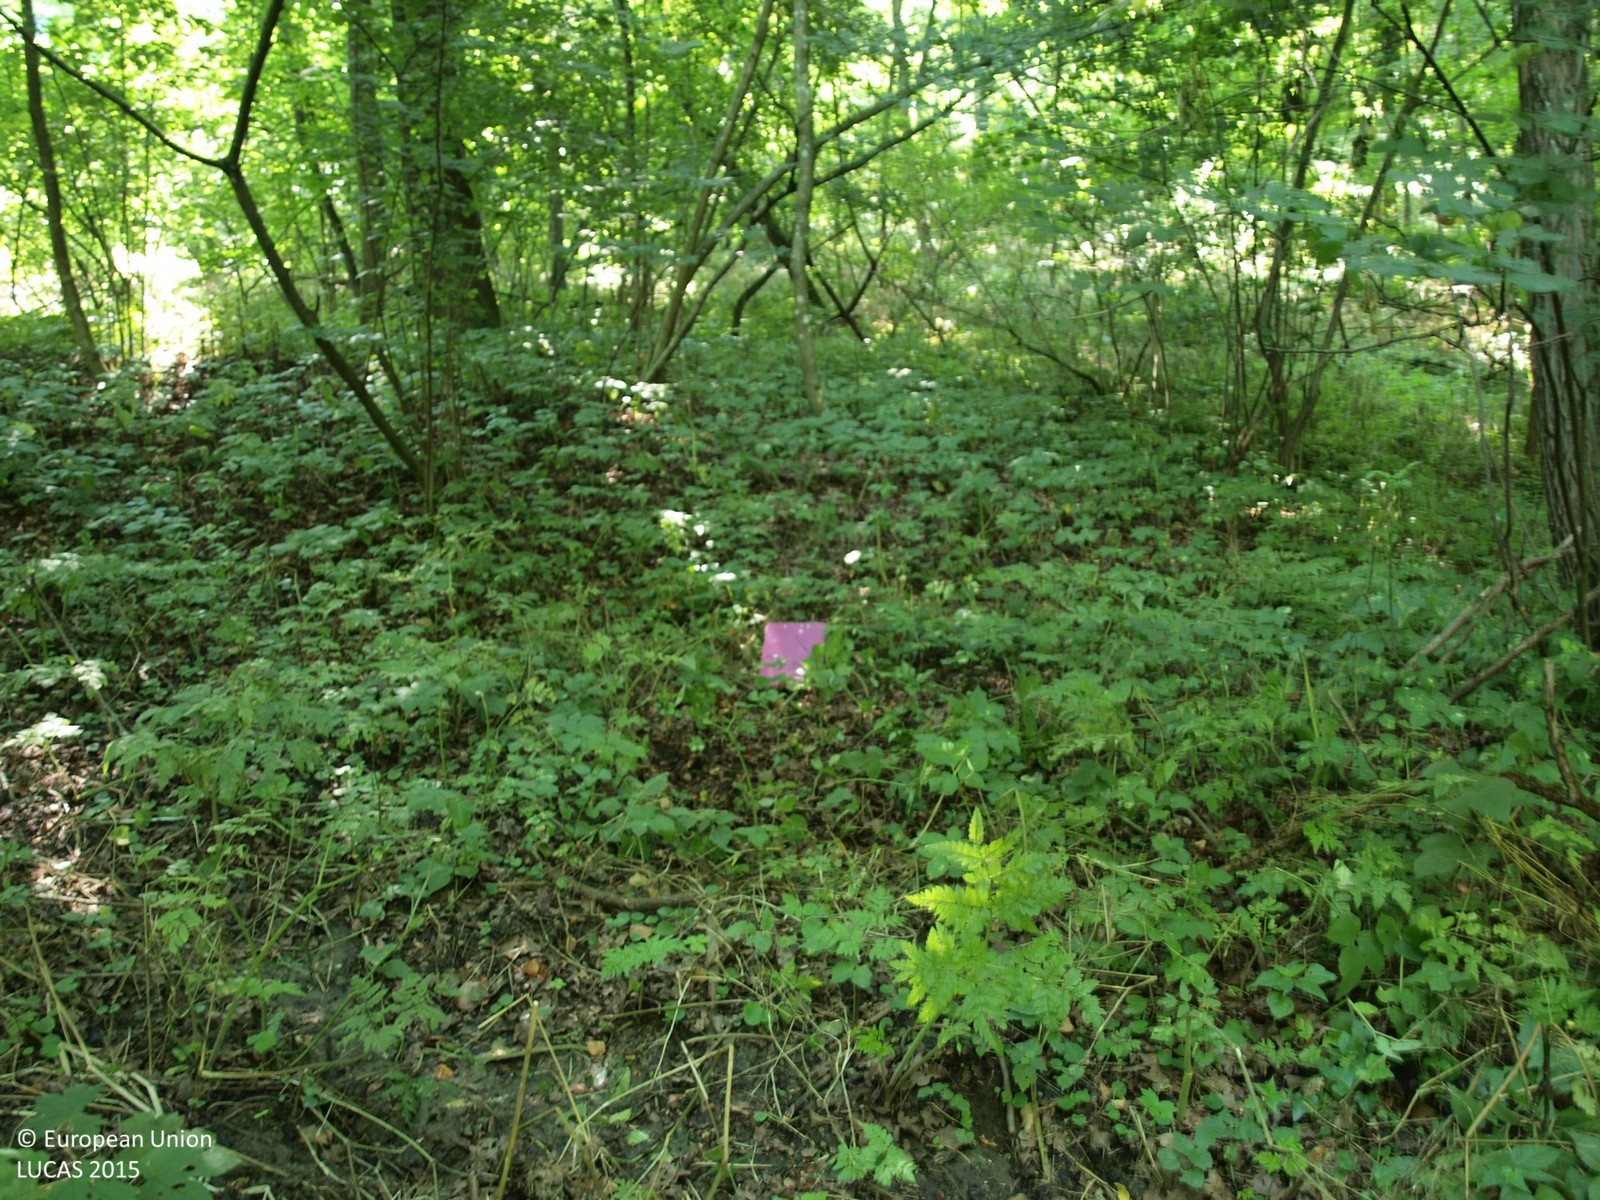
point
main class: Woodland
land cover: Broadleaved woodland
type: mesophytic deciduous forest
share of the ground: > 75 %
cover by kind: broadleaved forest trees 100 %
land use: Forestry
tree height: > 5 m
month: July
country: HR
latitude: 45.9869
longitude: 15.9495
